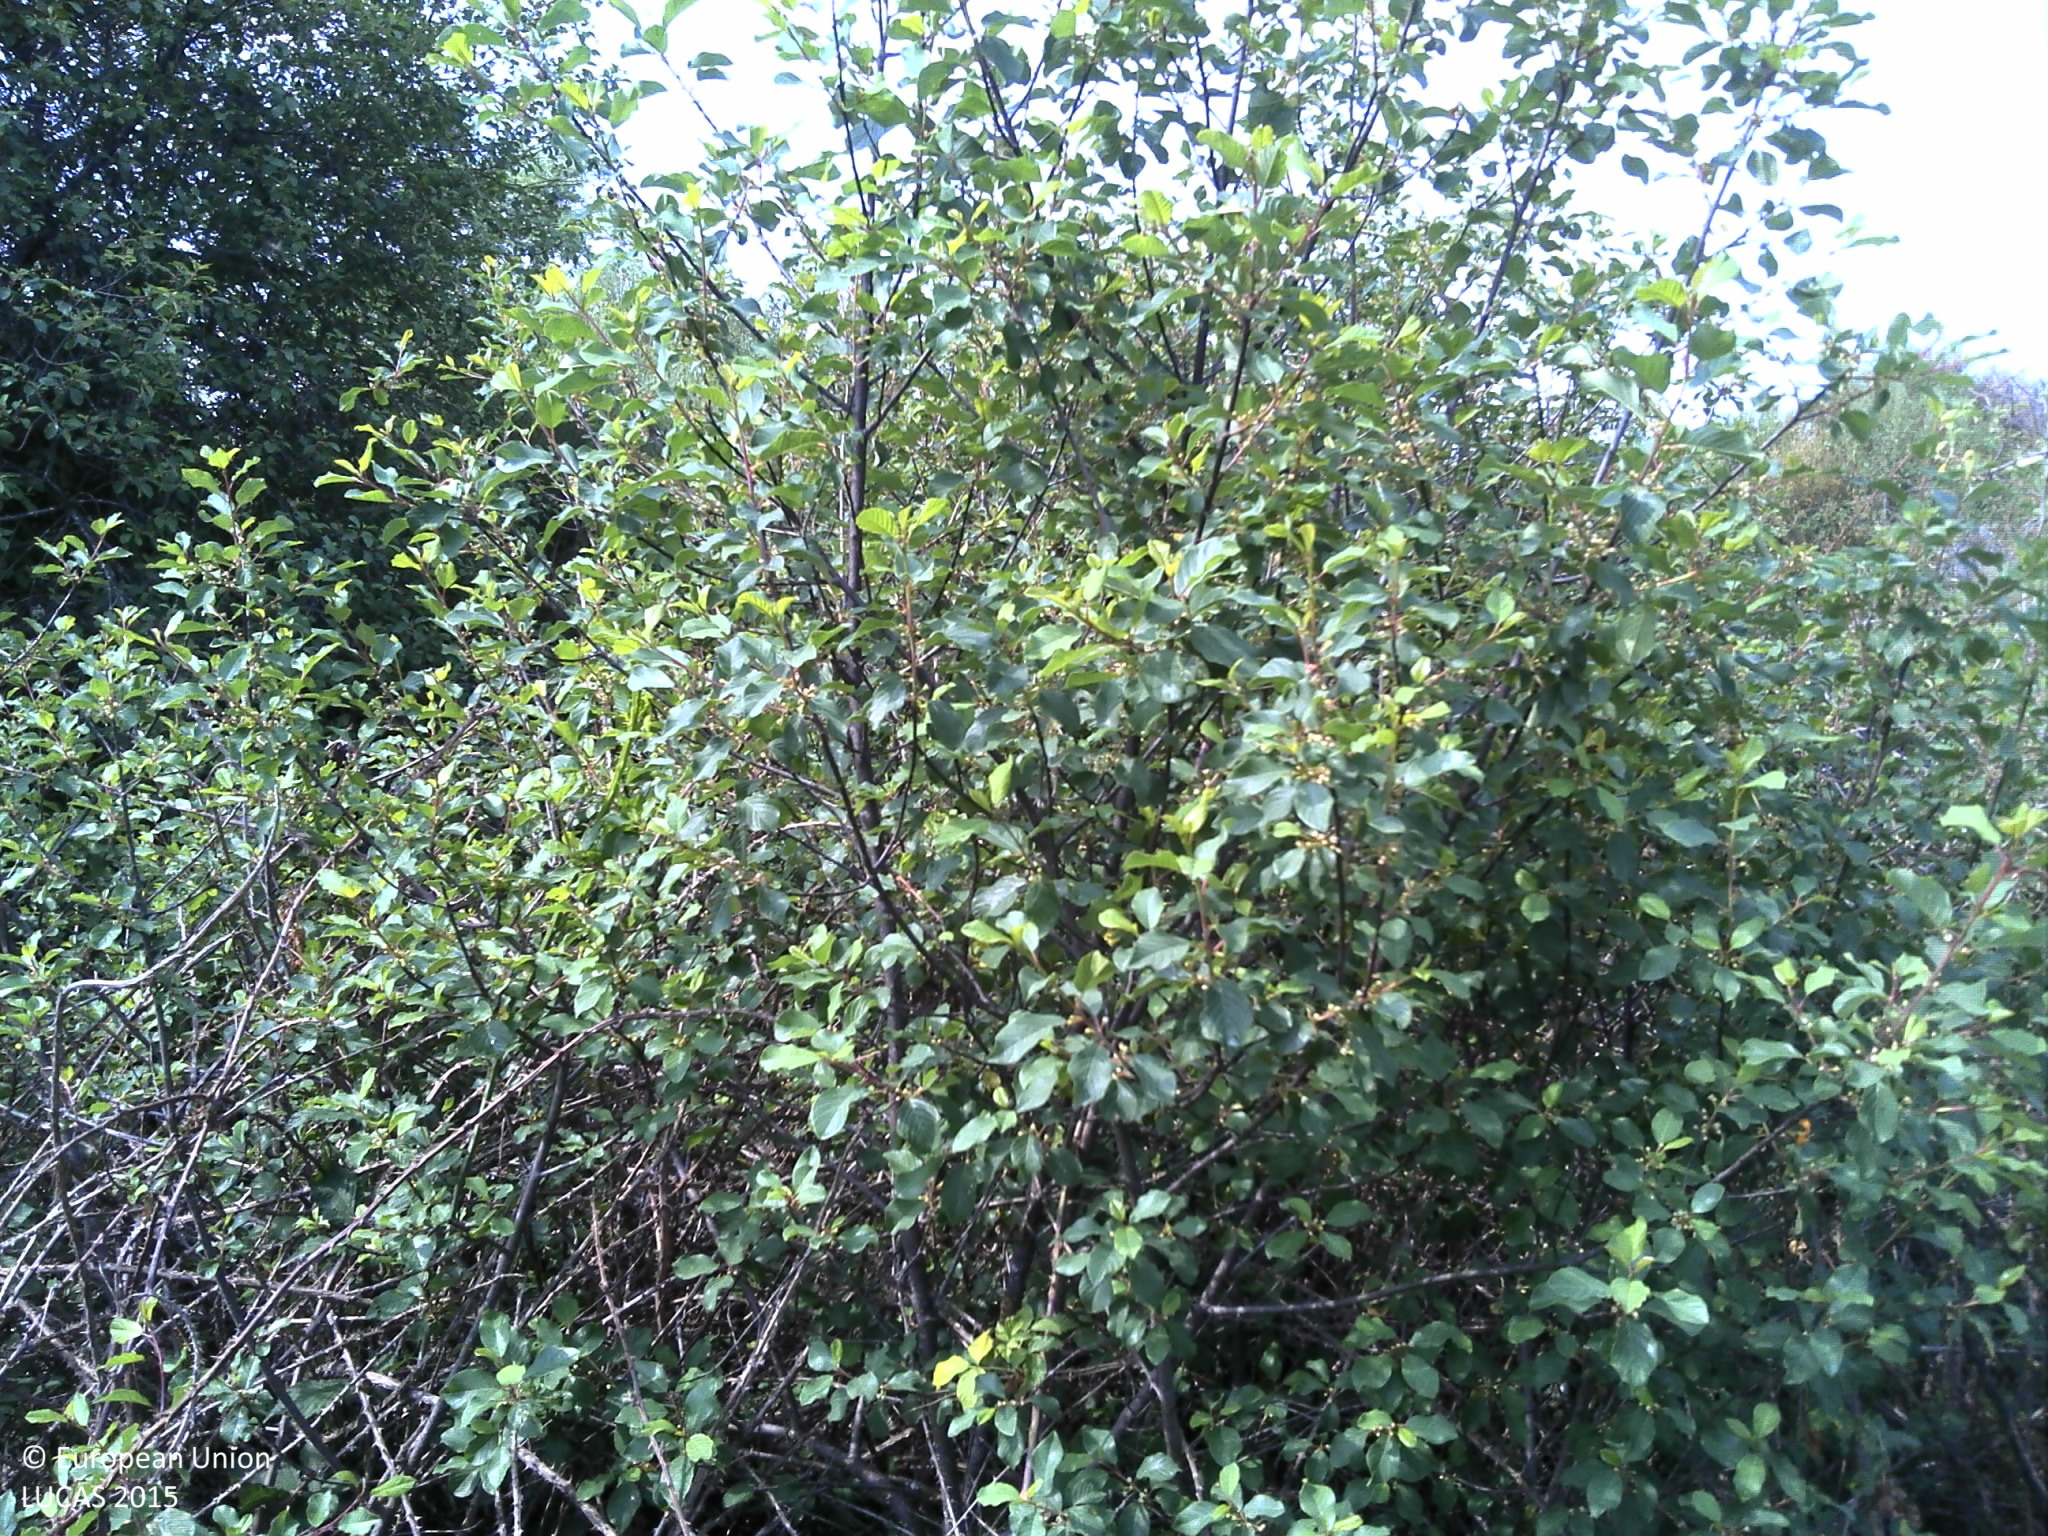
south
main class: Shrubland
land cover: Shrubland with sparse tree cover
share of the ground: > 75 %
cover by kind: shrubs 95 %, broadleaved forest trees 5 %
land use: Semi-natural and natural areas not in use
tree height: > 5 m
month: June
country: PT
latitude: 41.4409
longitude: -7.5417
